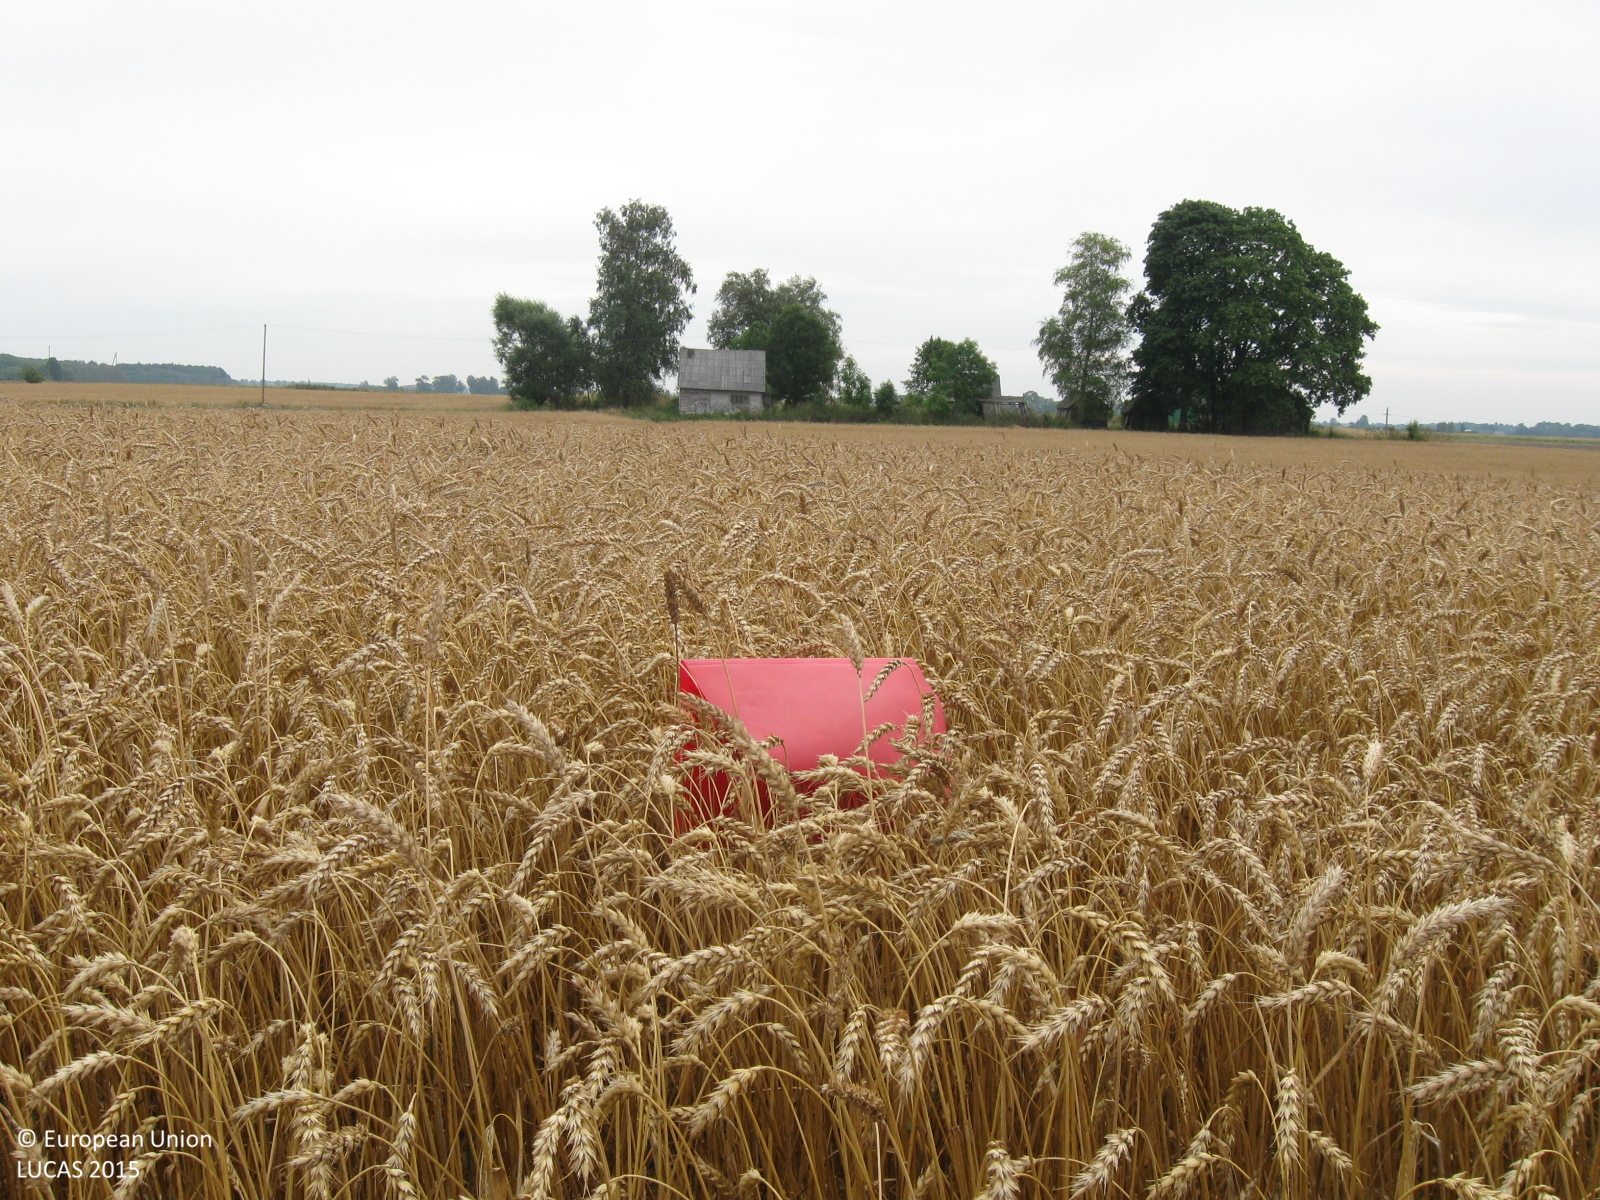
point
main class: Cropland
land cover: Common wheat
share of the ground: > 75 %
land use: Agriculture (excluding fallow land and kitchen gardens)
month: August
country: LT
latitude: 55.1168
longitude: 23.3893
